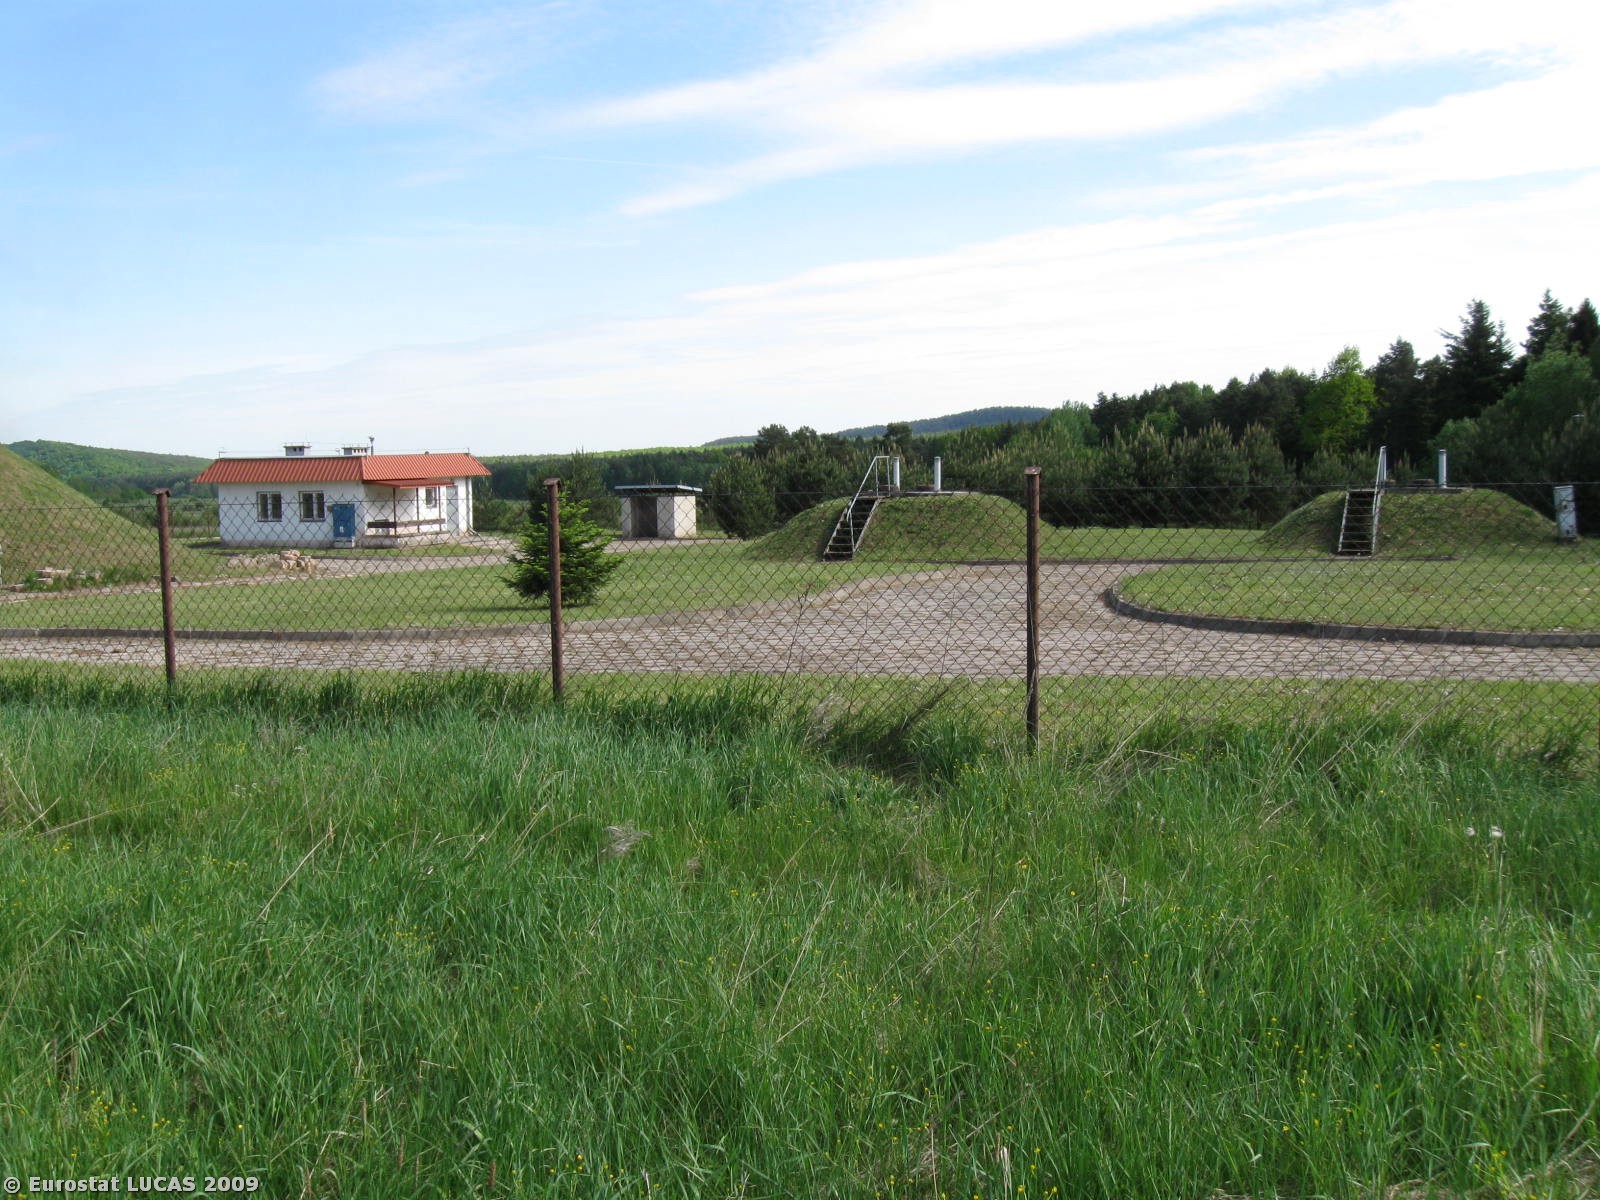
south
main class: Grassland
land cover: Grassland without tree/shrub cover
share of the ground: > 75 %
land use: Unused
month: May
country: PL
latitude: 50.8453
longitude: 20.4480
